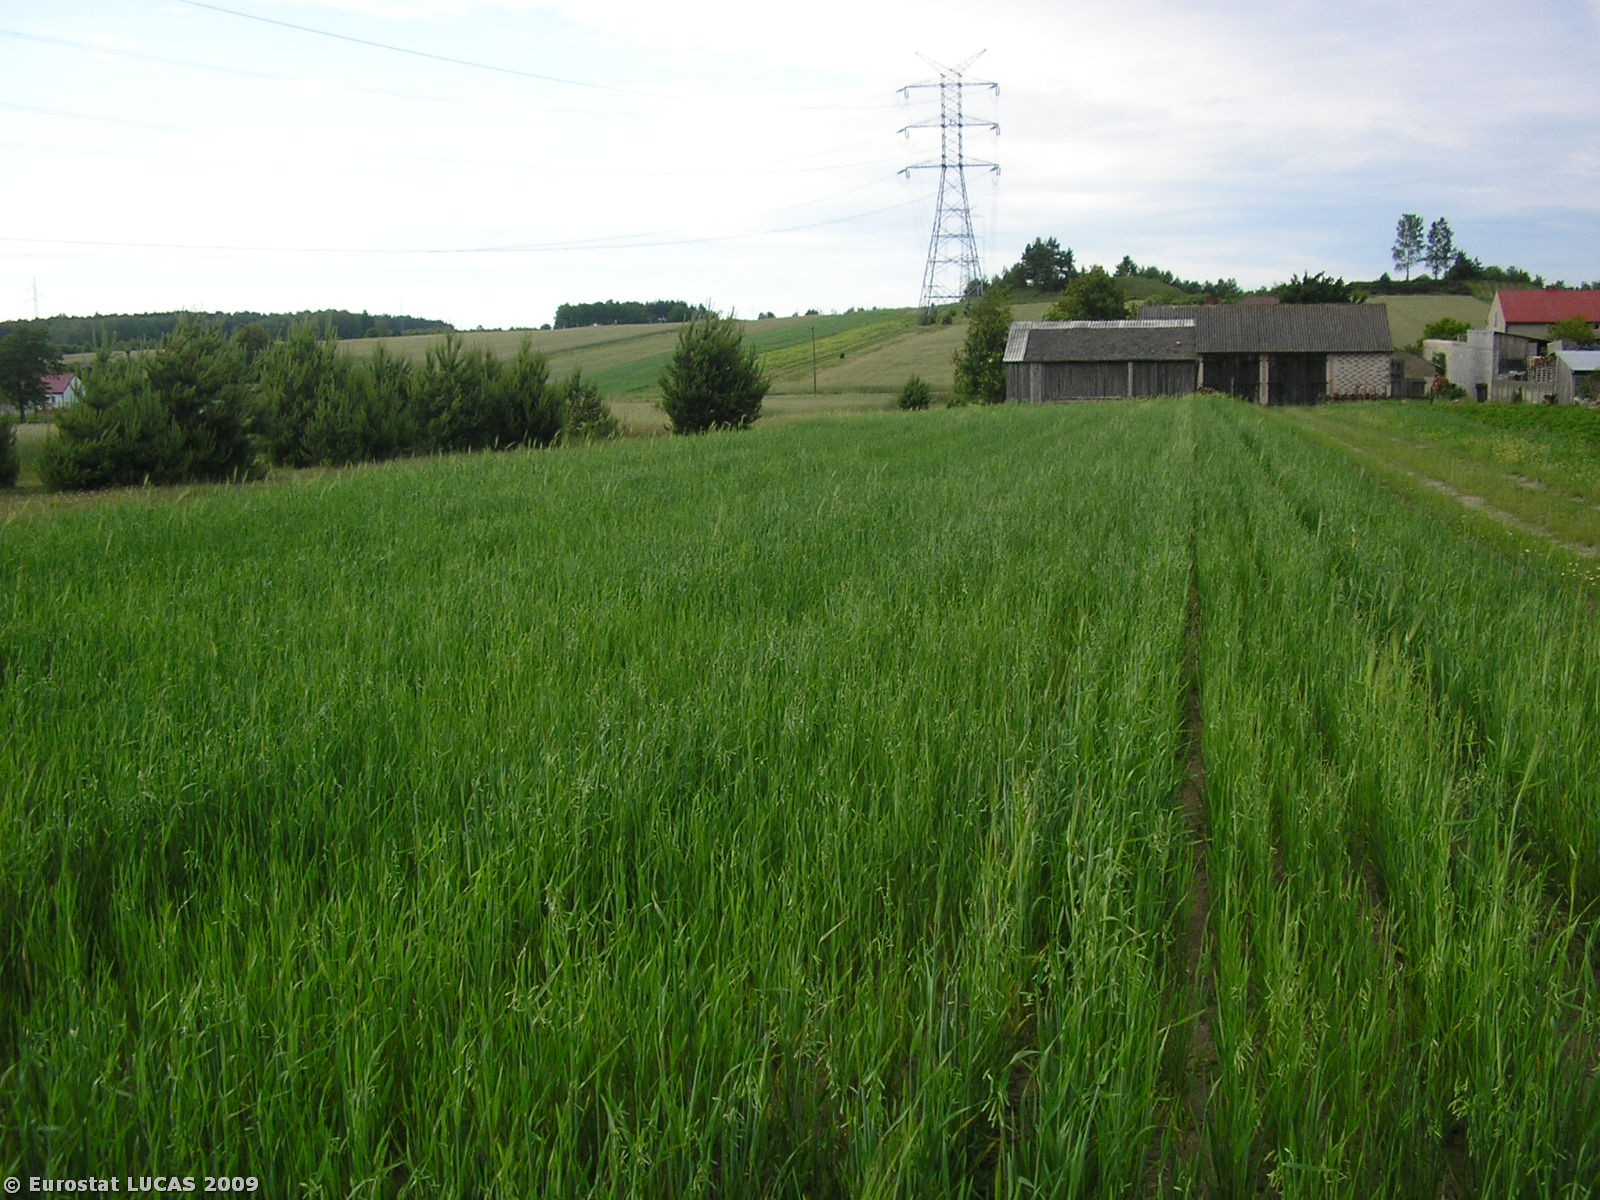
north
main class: Cropland
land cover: Oats
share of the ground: > 75 %
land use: Agriculture (excluding fallow land and kitchen gardens)
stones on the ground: < 10 %
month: June
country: PL
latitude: 51.1740
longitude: 18.9050
